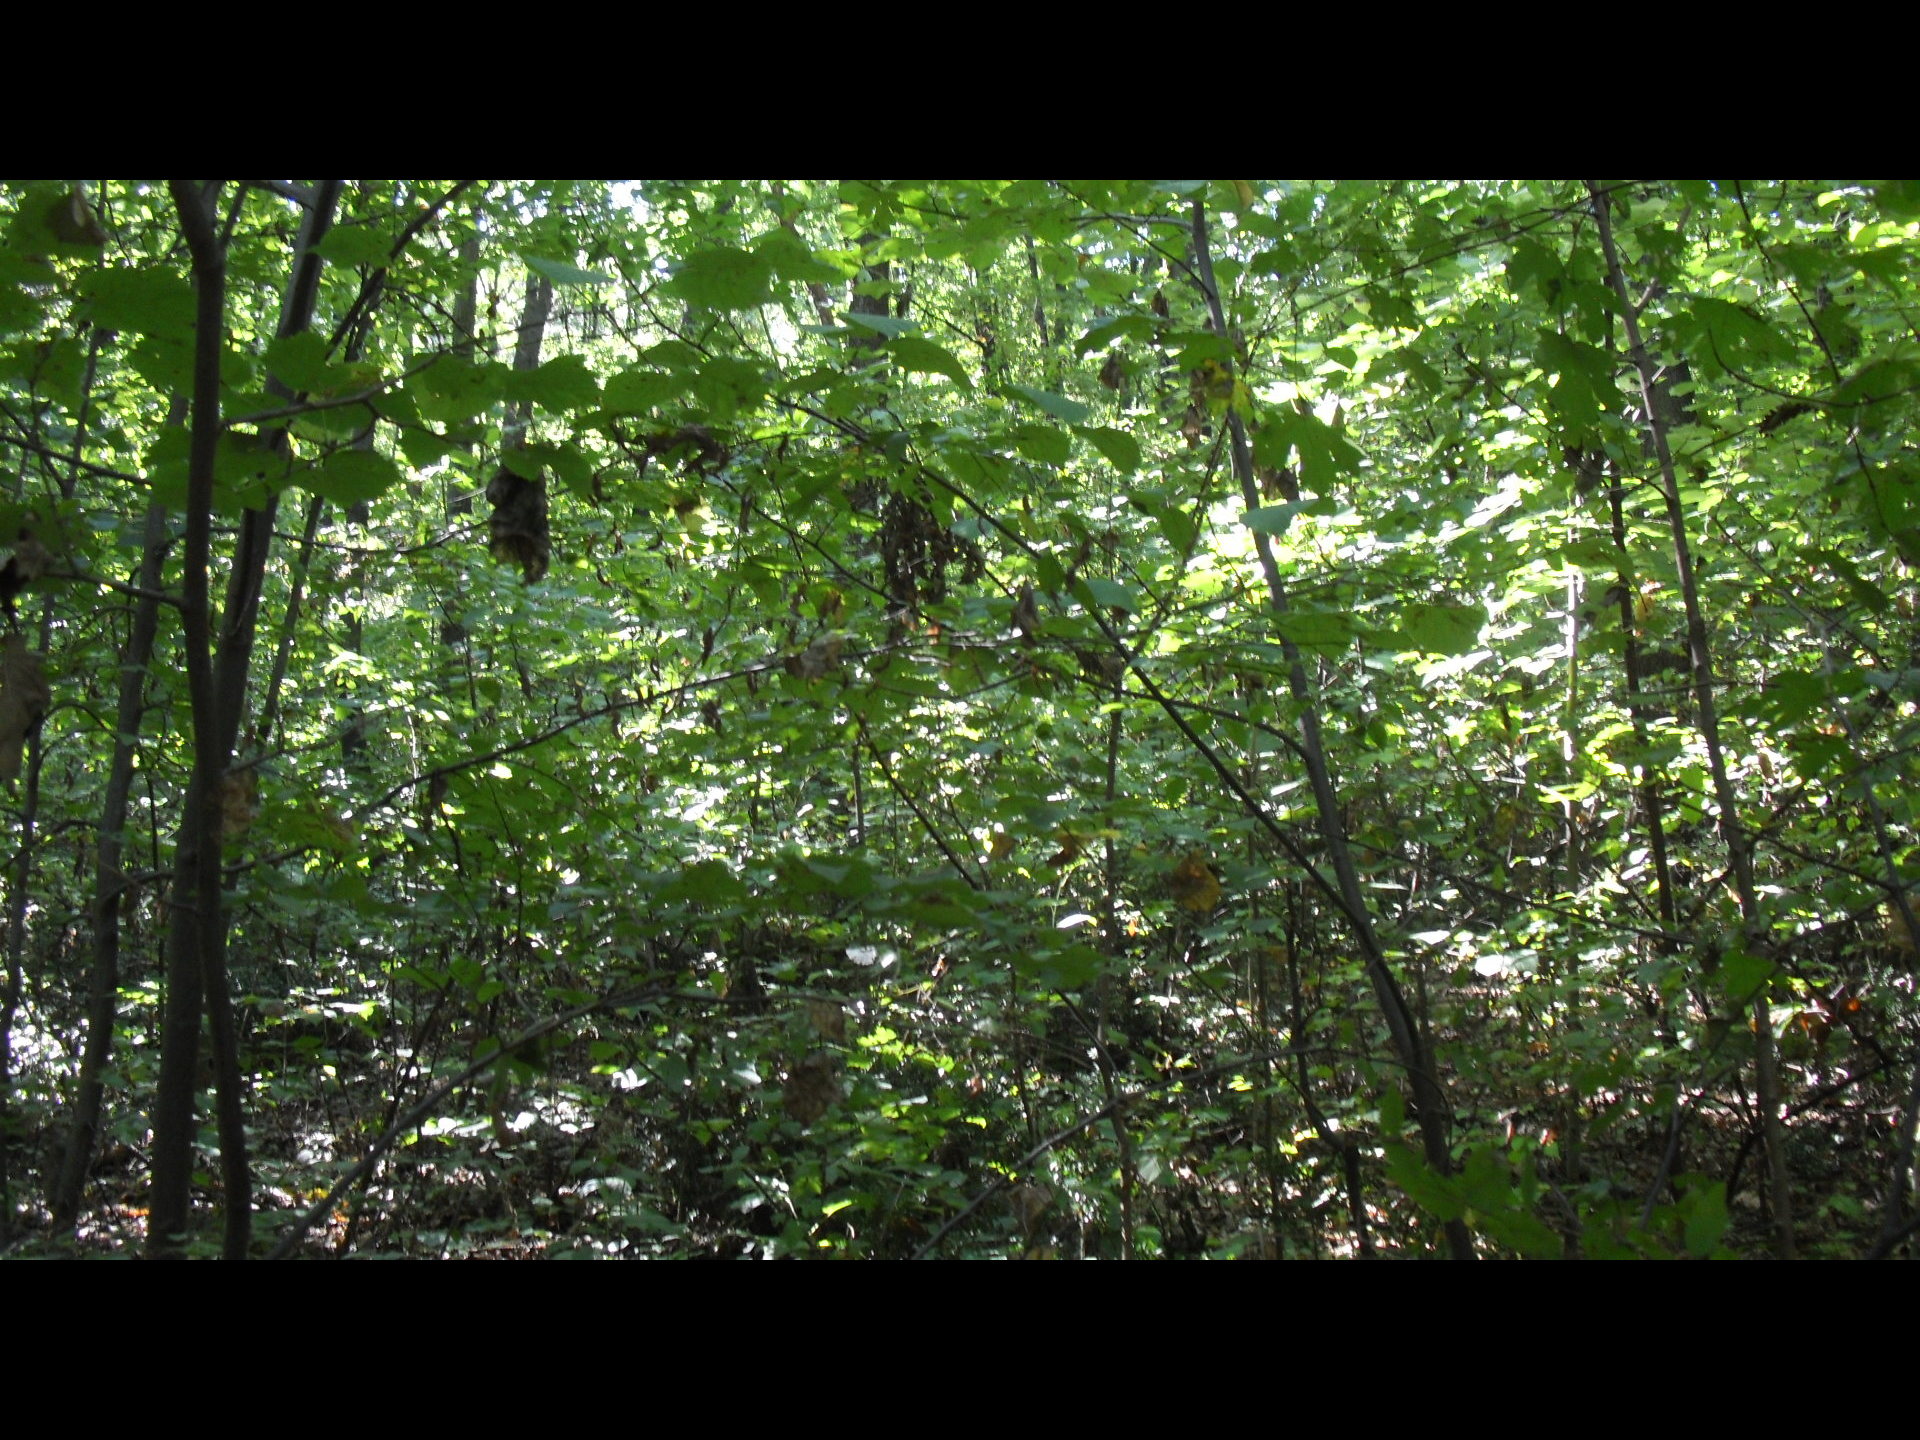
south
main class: Woodland
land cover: Broadleaved woodland
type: mesophytic deciduous forest
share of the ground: > 75 %
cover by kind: broadleaved forest trees 100 %
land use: Forestry
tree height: > 5 m
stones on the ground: < 10 %
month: October
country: BG
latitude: 43.8893
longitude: 22.7461
